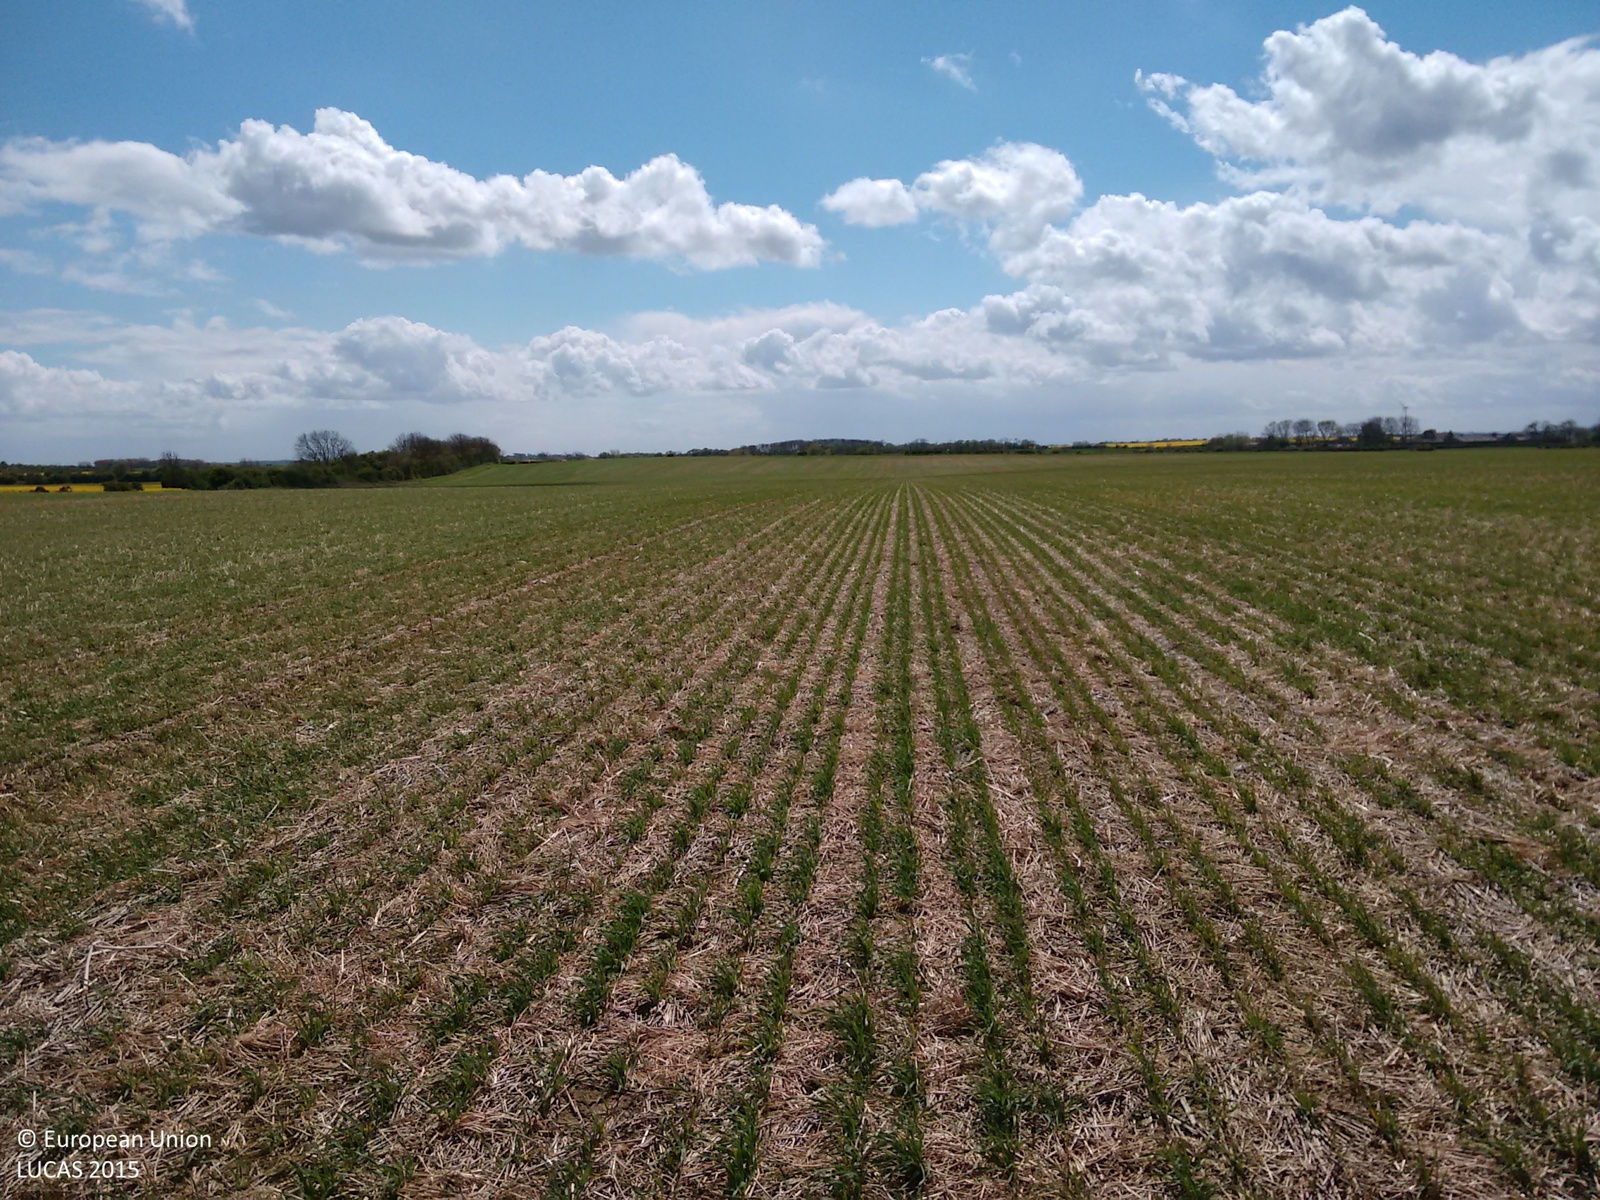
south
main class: Cropland
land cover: Barley
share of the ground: 25 - 50 %
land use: Agriculture (excluding fallow land and kitchen gardens)
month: May
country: GB
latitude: 53.8630
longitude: -0.1446
